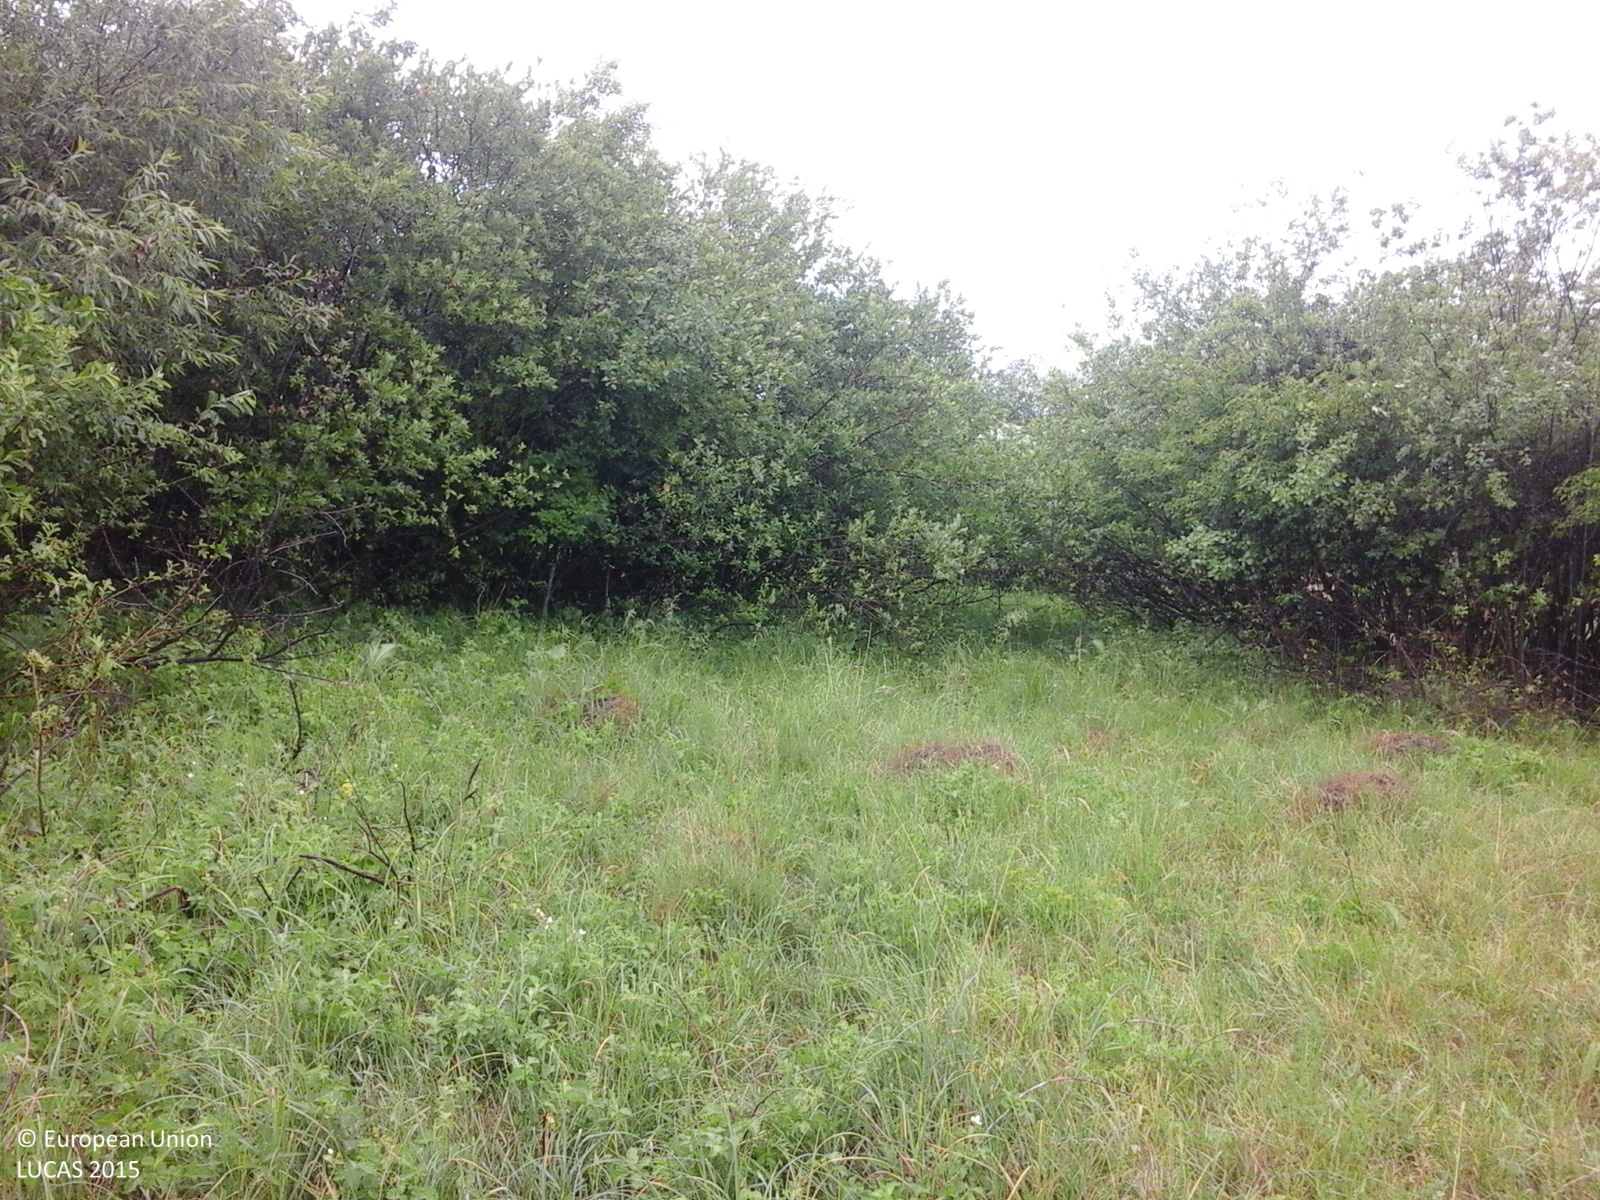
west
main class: Grassland
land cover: Grassland without tree/shrub cover
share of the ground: > 75 %
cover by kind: herbaceous plants 100 %
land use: Agriculture (excluding fallow land and kitchen gardens)
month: June
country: RO
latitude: 47.4361
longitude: 26.3262
